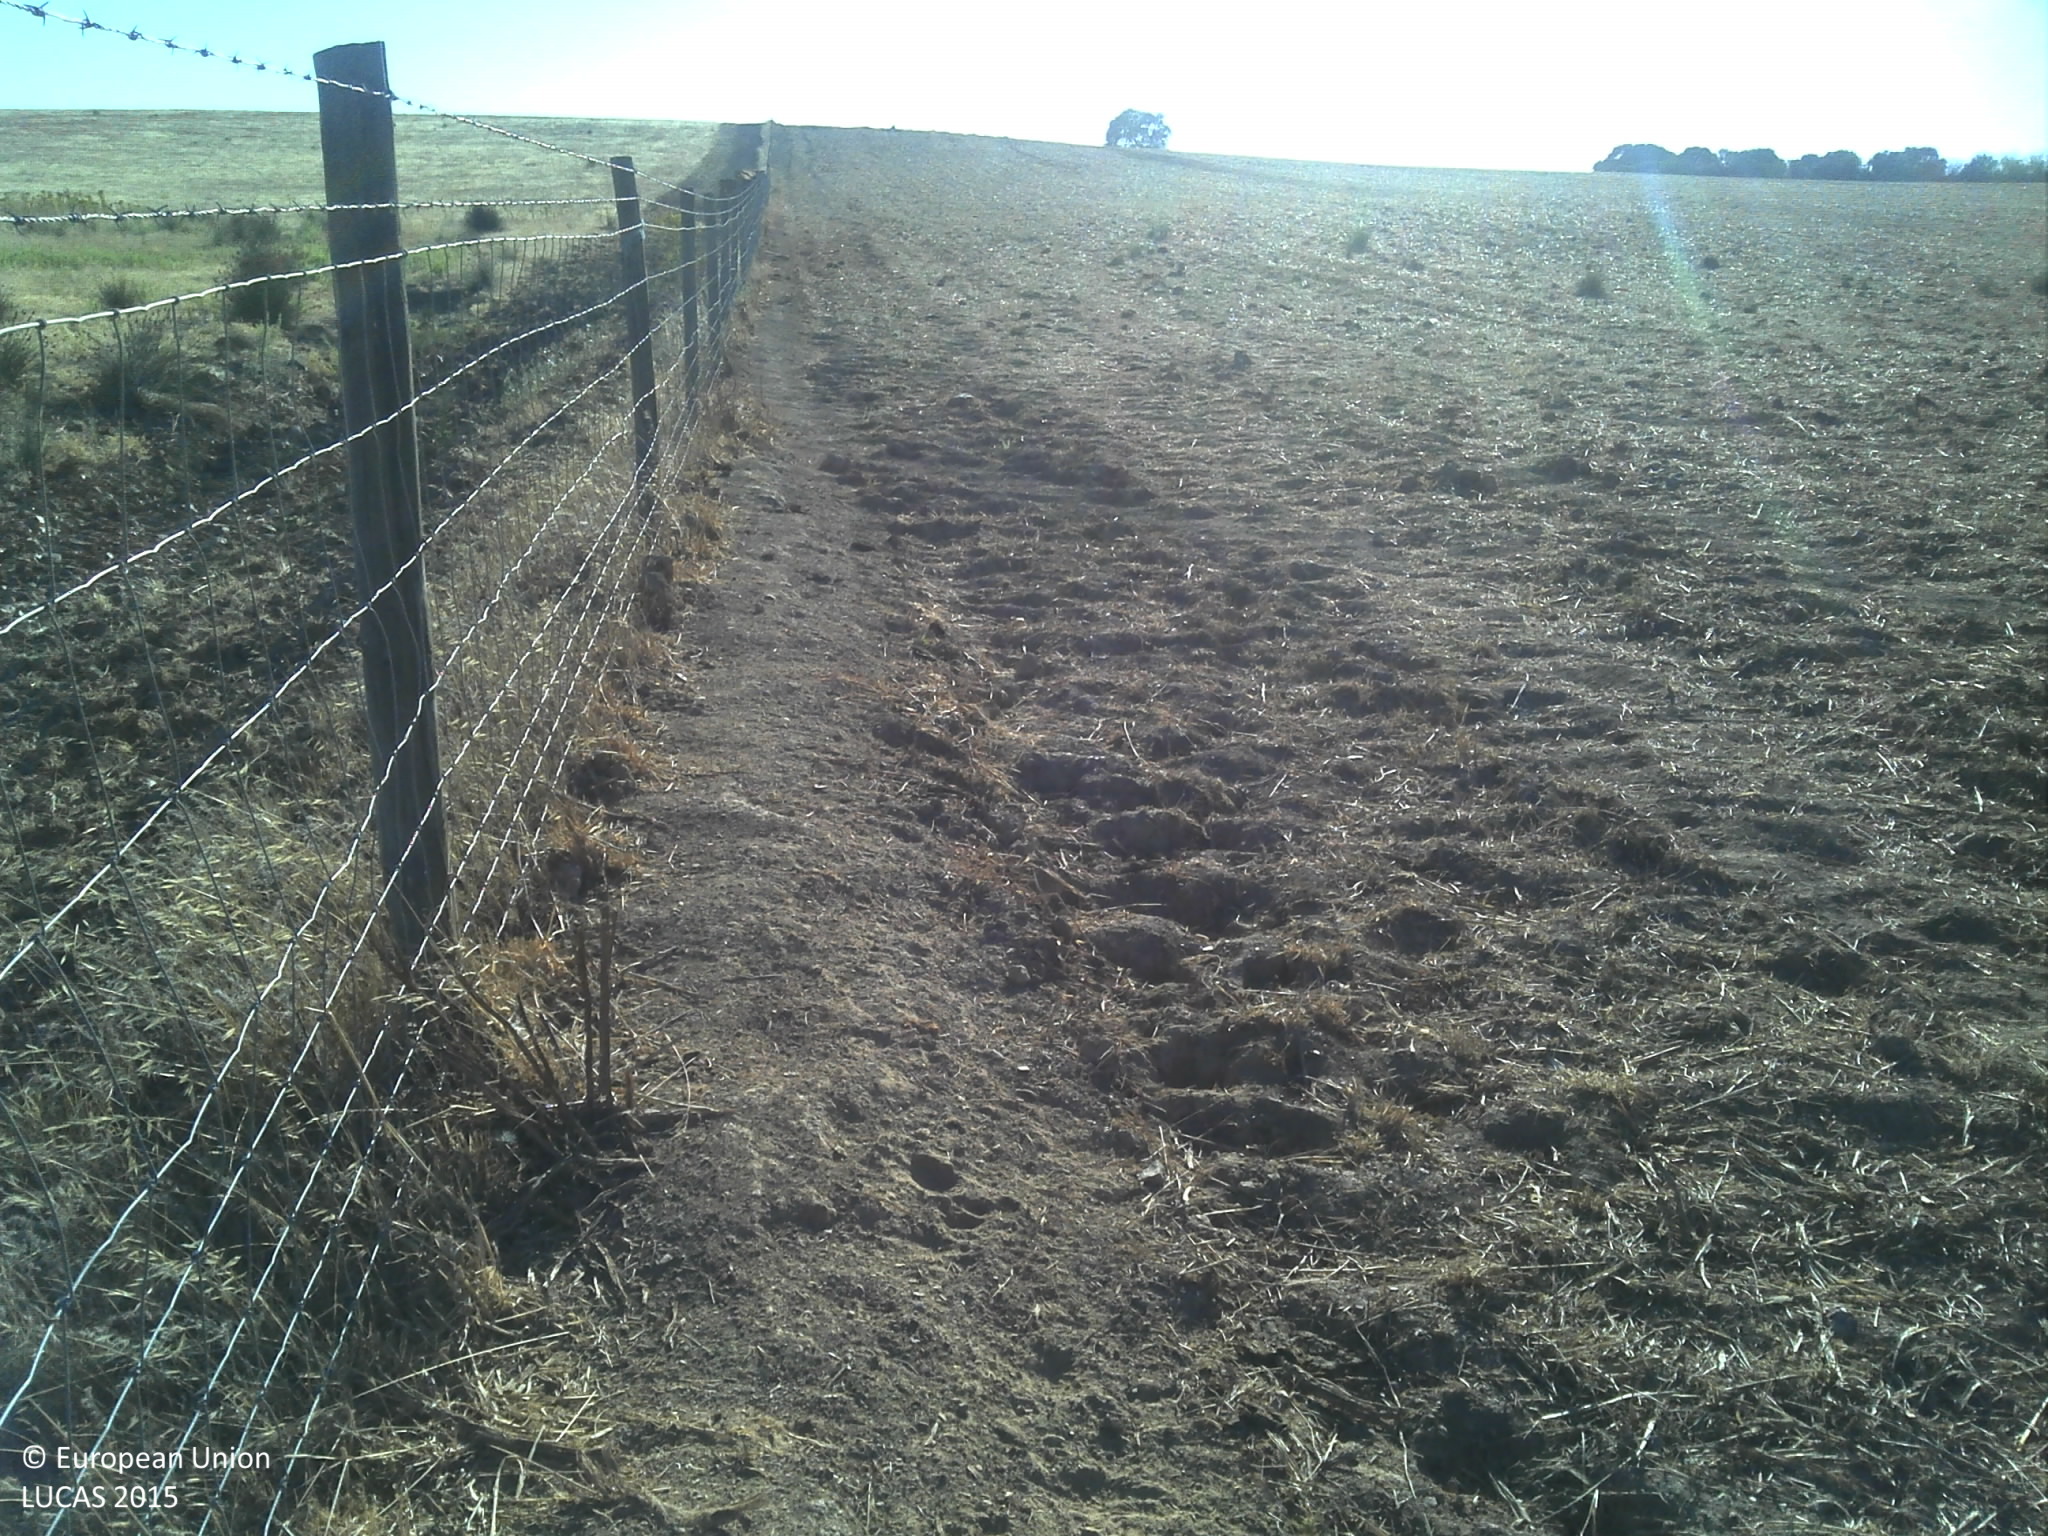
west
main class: Grassland
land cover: Grassland without tree/shrub cover
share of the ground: > 75 %
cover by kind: herbaceous plants 95 %, unconsolidated bare surface 5 %
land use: Agriculture (excluding fallow land and kitchen gardens)
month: July
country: PT
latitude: 37.8792
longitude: -8.0264
